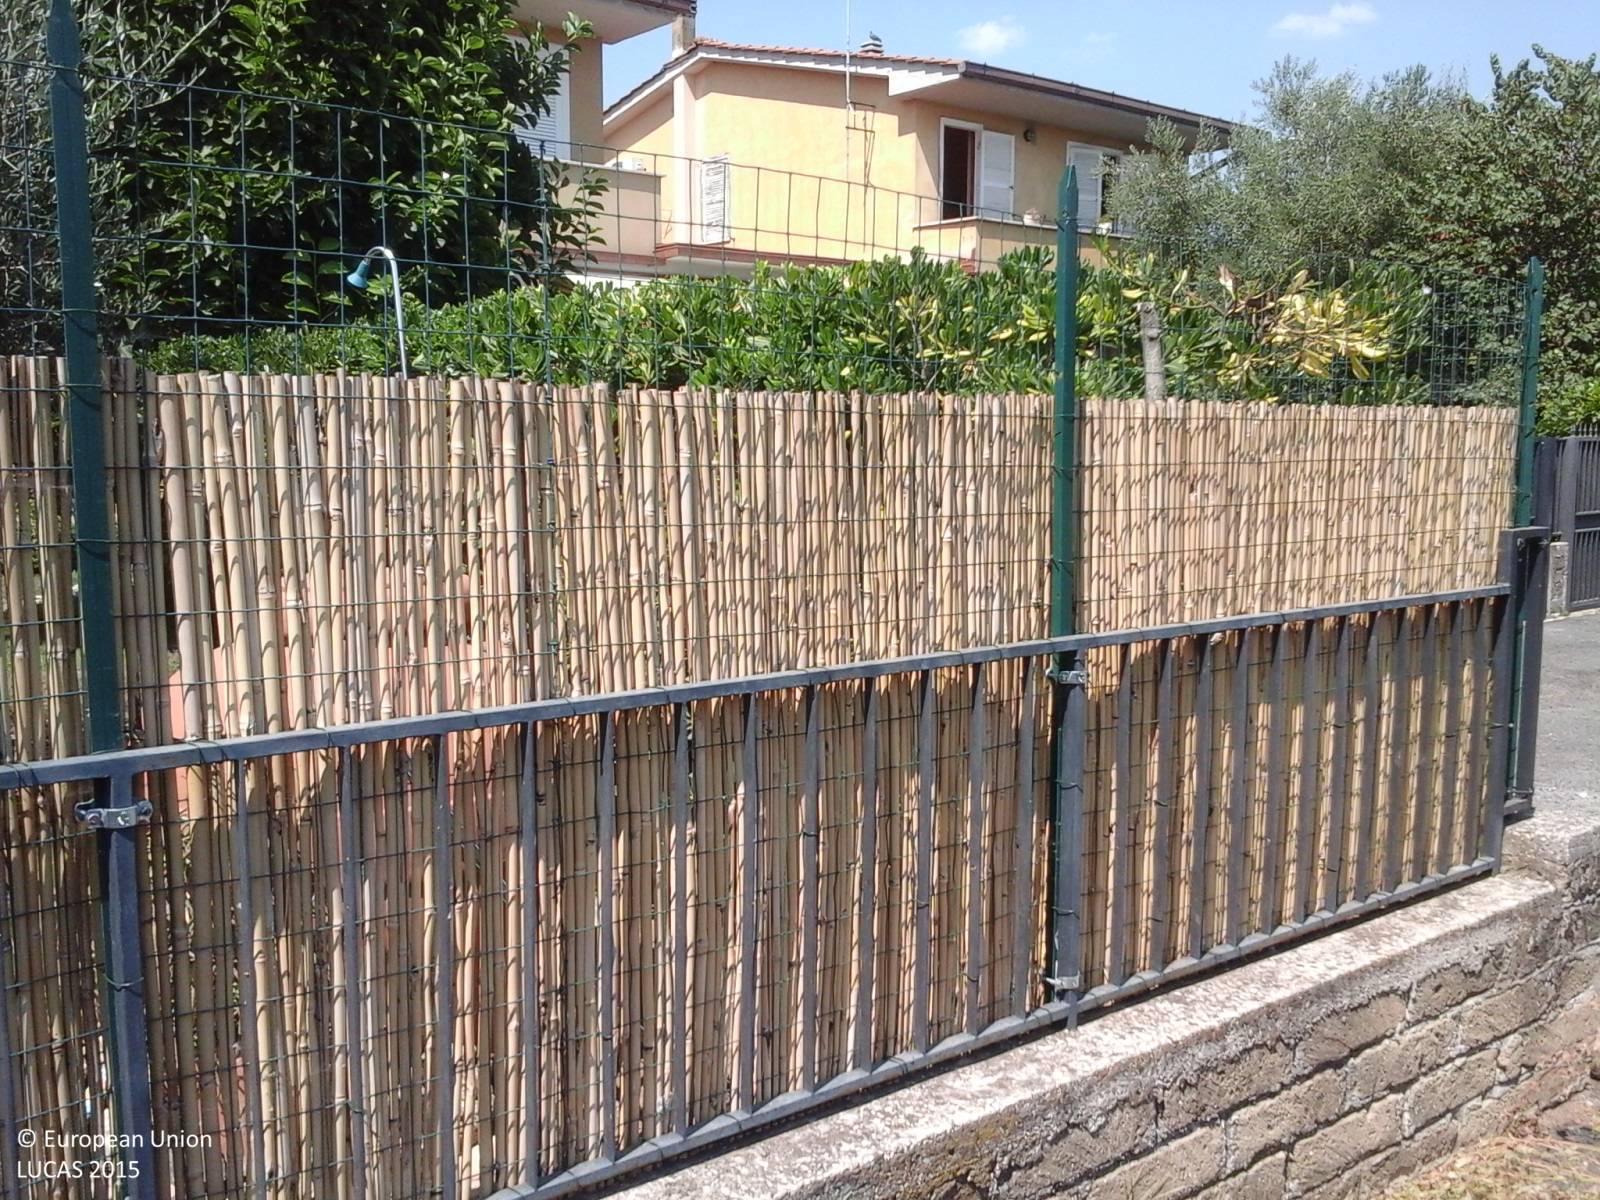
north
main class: Grassland
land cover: Grassland with sparse tree/shrub cover
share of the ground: > 75 %
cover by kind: herbaceous plants 90 %, broadleaved forest trees 5 %, shrubs 5 %
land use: Residential
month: August
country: IT
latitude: 42.0863
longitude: 12.2766
